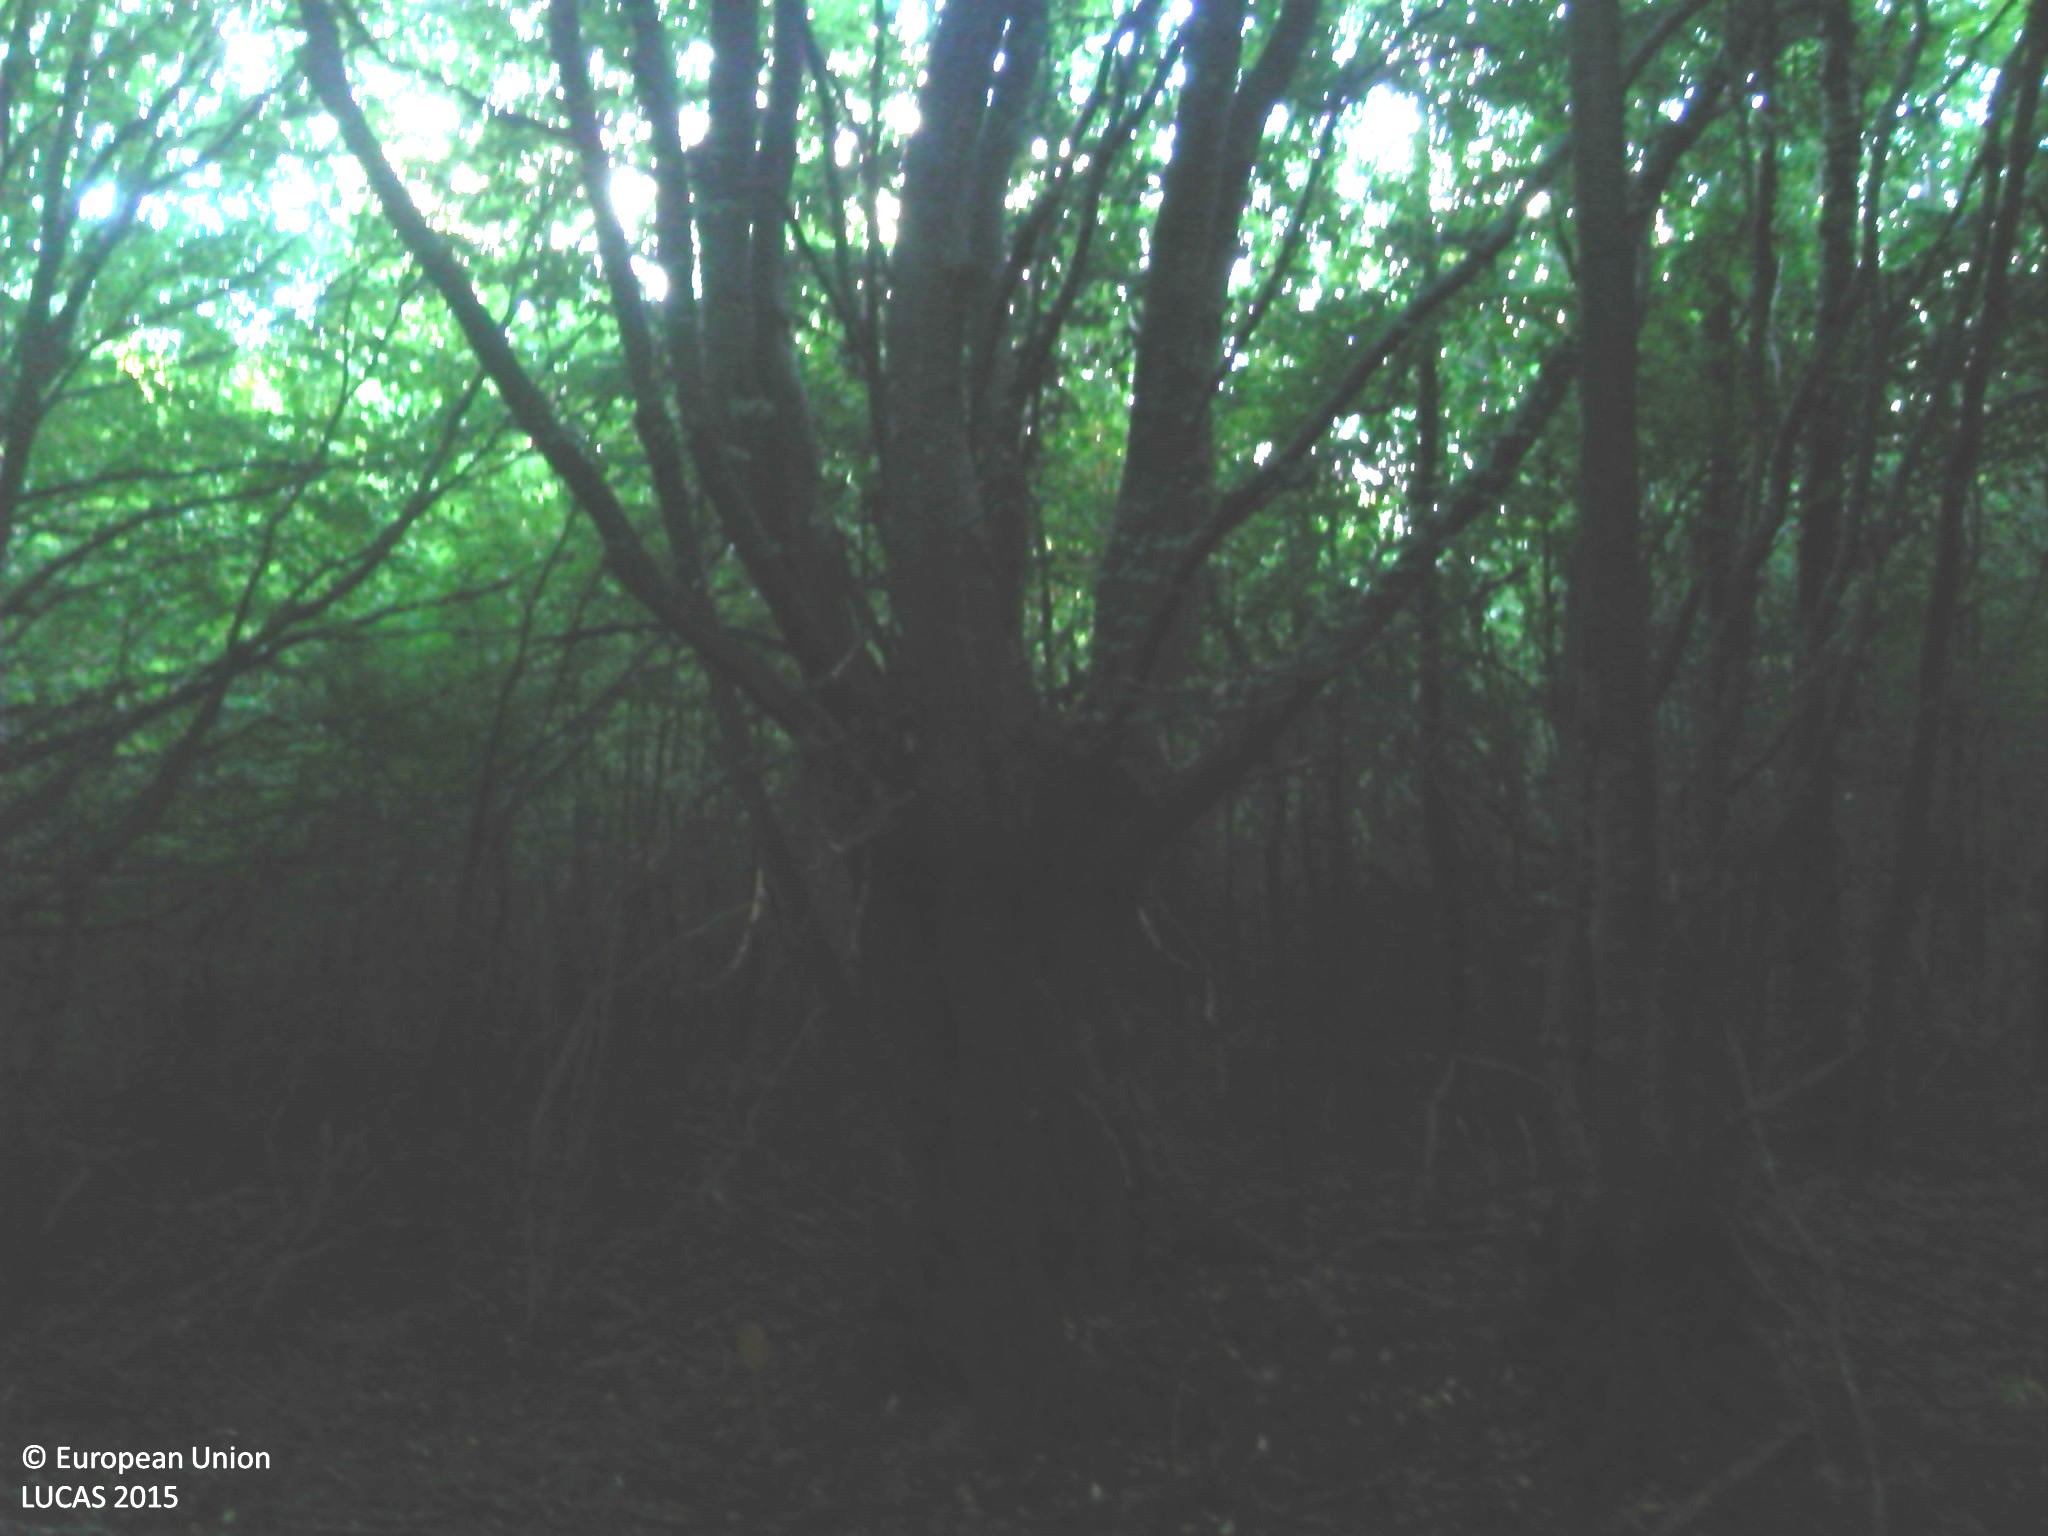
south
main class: Woodland
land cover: Spruce dominated mixed woodland
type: mesophytic deciduous forest
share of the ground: > 75 %
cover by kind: coniferous forest trees 45 %, broadleaved forest trees 25 %, shrubs 10 %, herbaceous plants 10 %, lichens and mosses 10 %
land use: Forestry
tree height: > 5 m
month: September
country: FR
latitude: 48.4714
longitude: 0.7936
